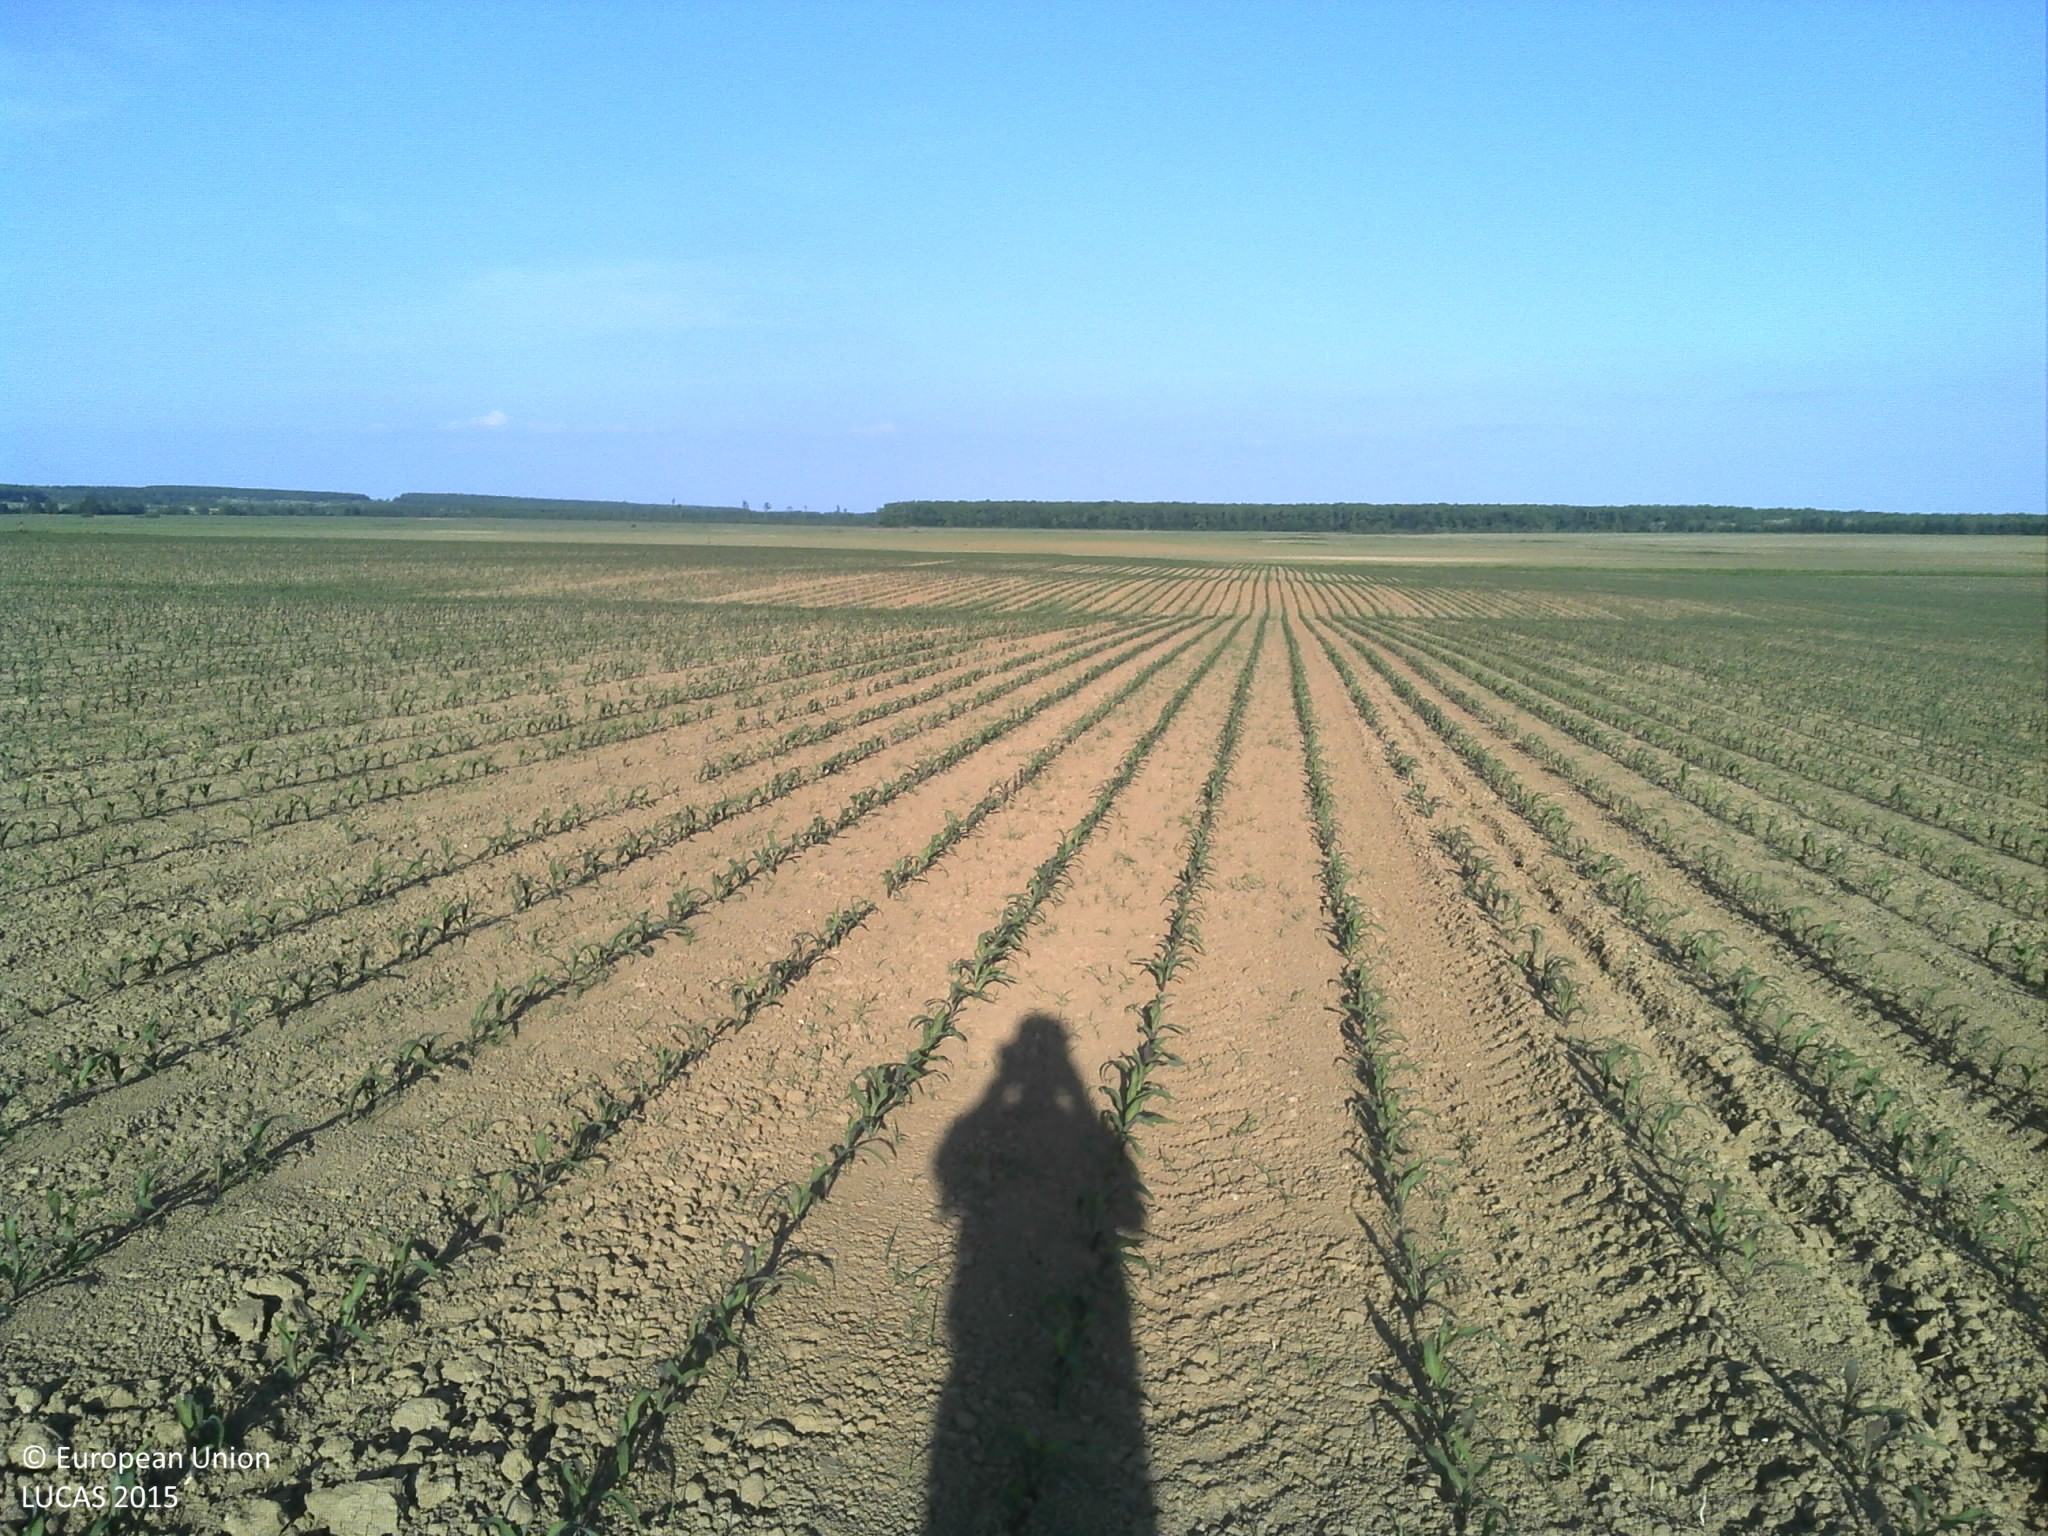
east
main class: Cropland
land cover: Maize
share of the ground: < 10 %
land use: Agriculture (excluding fallow land and kitchen gardens)
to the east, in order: Maize
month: May
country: HR
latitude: 45.2358
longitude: 18.2455
